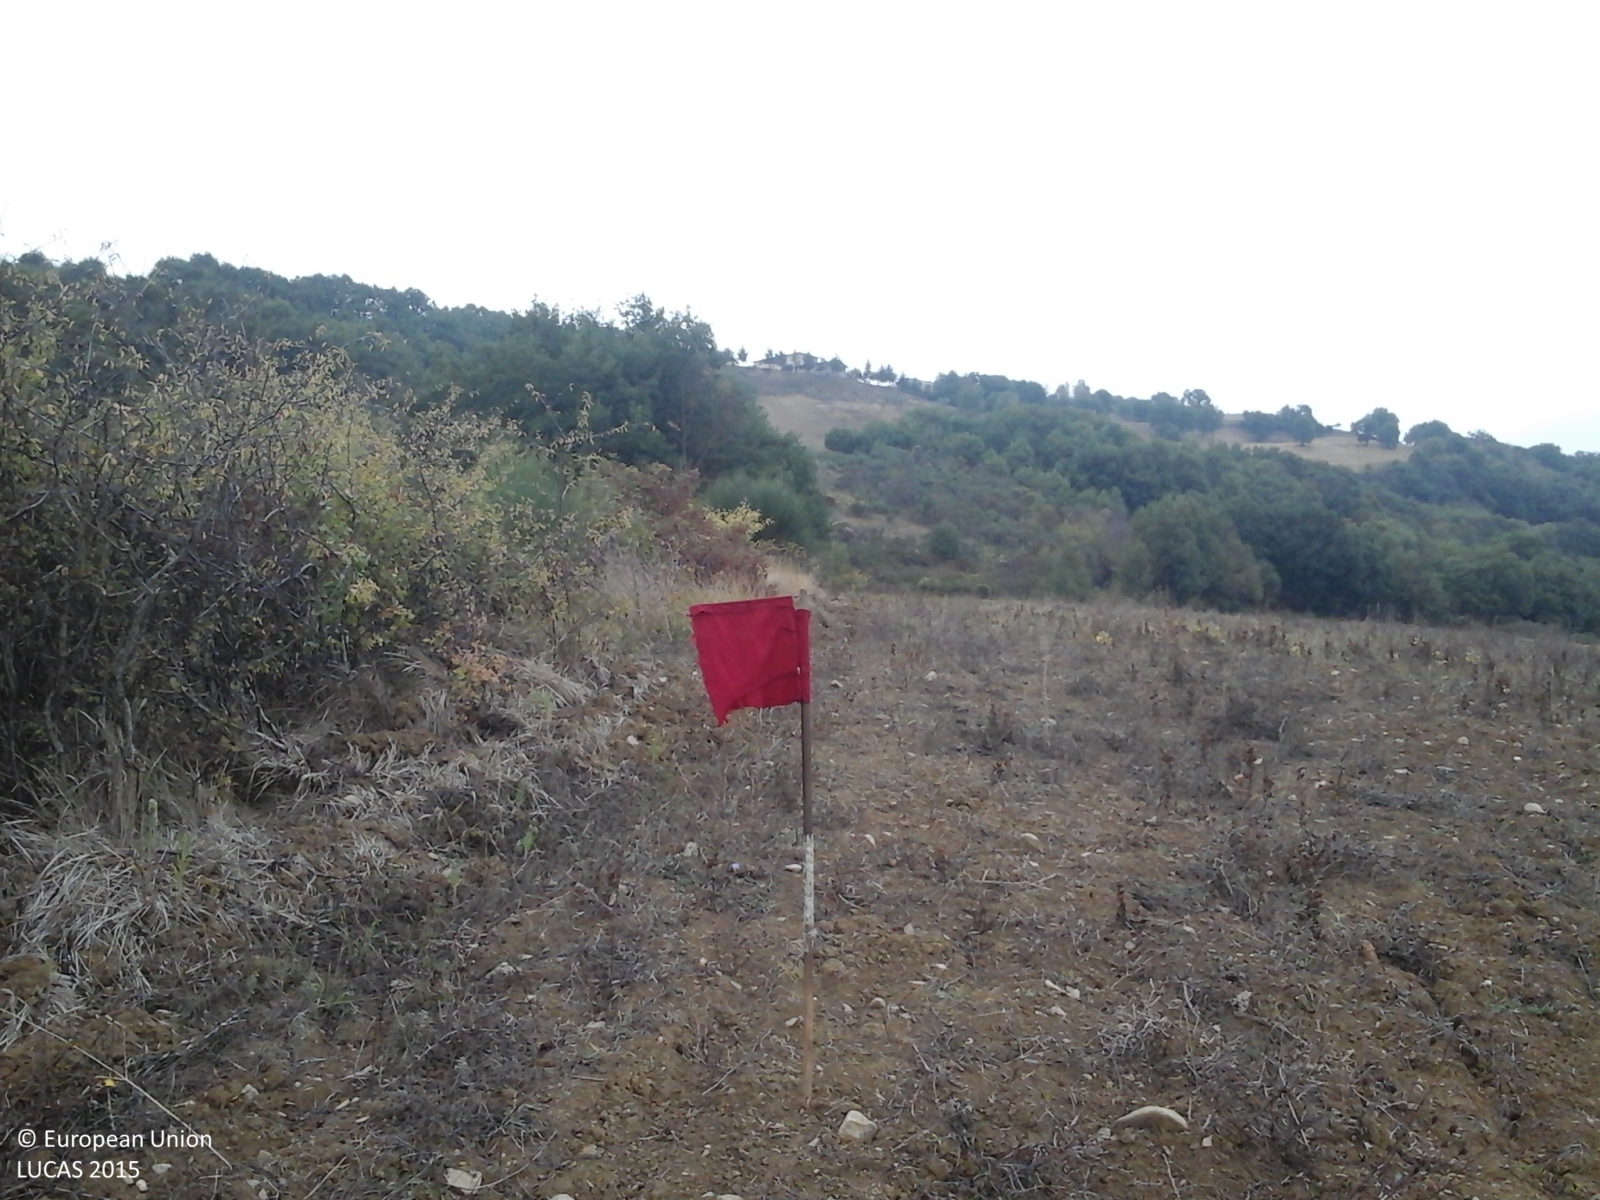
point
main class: Grassland
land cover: Spontaneously vegetated surfaces
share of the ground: 50 - 75 %
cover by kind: herbaceous plants 50 %, consolidated bare surface 35 %, unconsolidated bare surface 15 %
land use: Fallow land
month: October
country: IT
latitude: 43.3126
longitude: 12.3730
